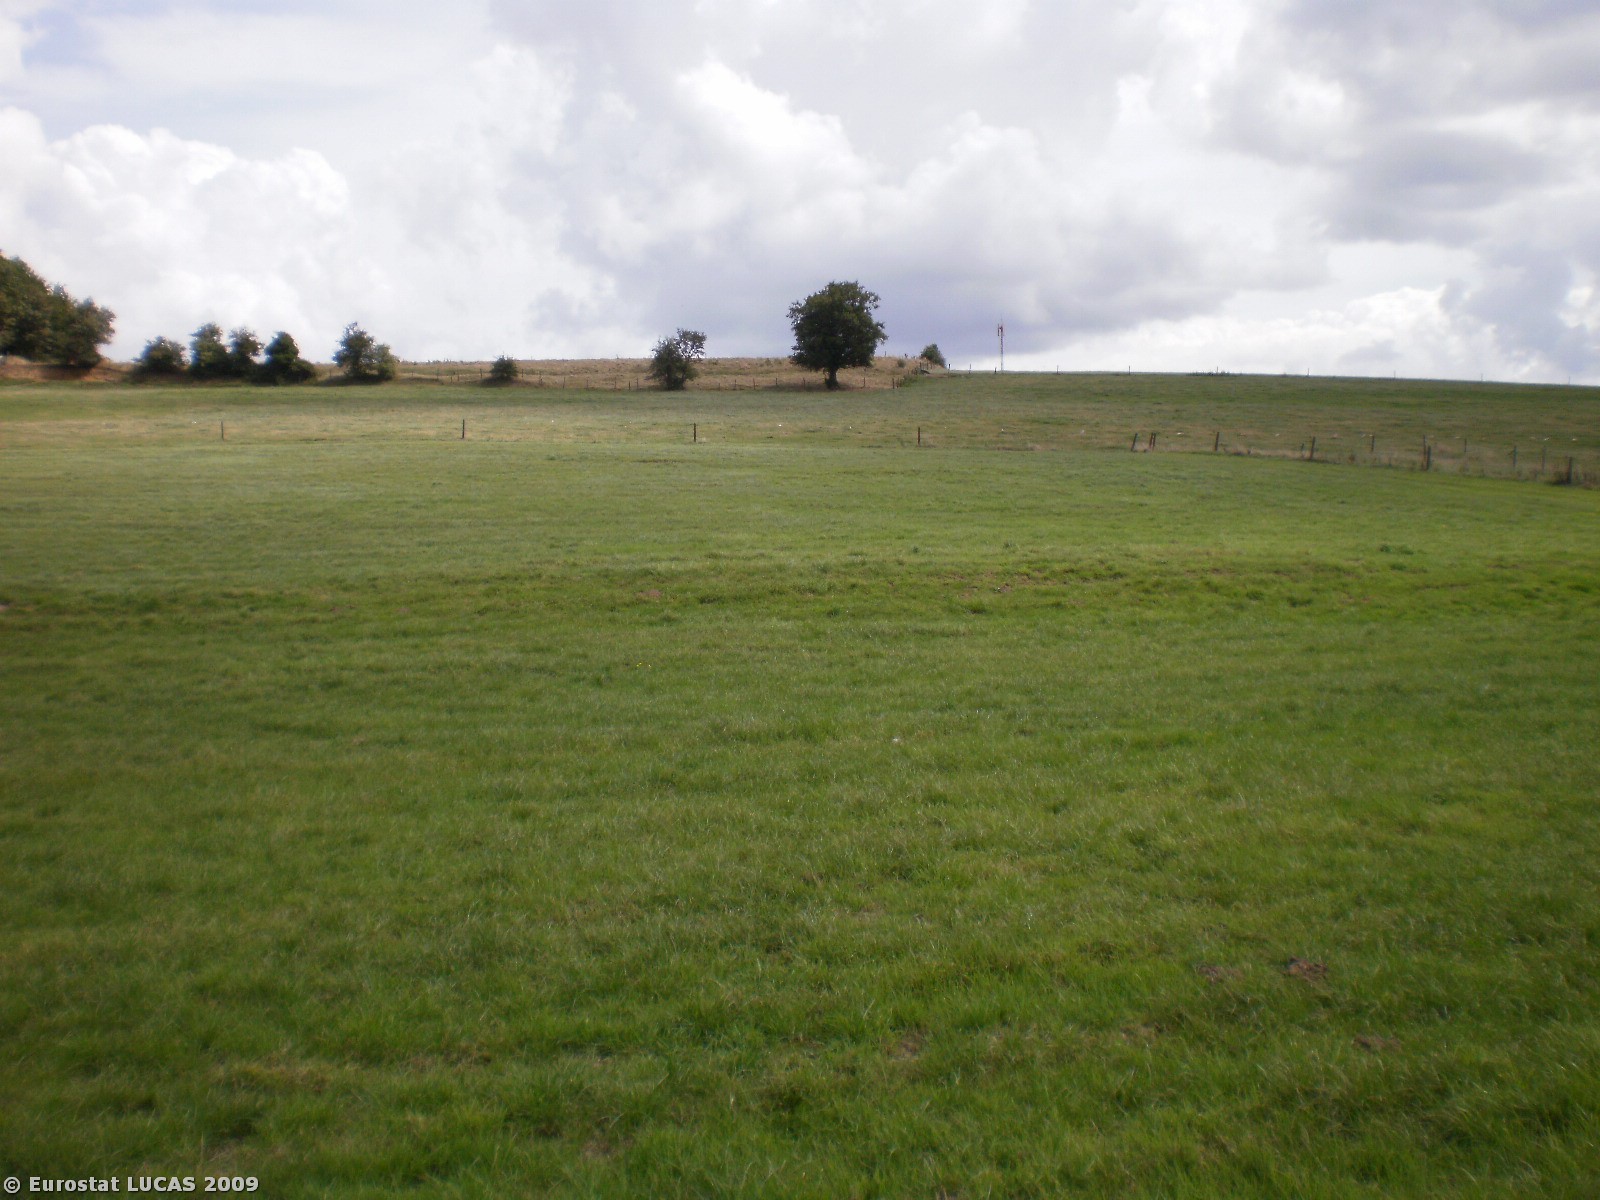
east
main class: Grassland
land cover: Grassland without tree/shrub cover
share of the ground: > 75 %
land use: Agriculture (excluding fallow land and kitchen gardens)
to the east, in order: Grassland without tree/shrub cover; Fences; Grassland without tree/shrub cover; Fences; Grassland without tree/shrub cover
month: July
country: BE
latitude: 50.7671
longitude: 2.7718
